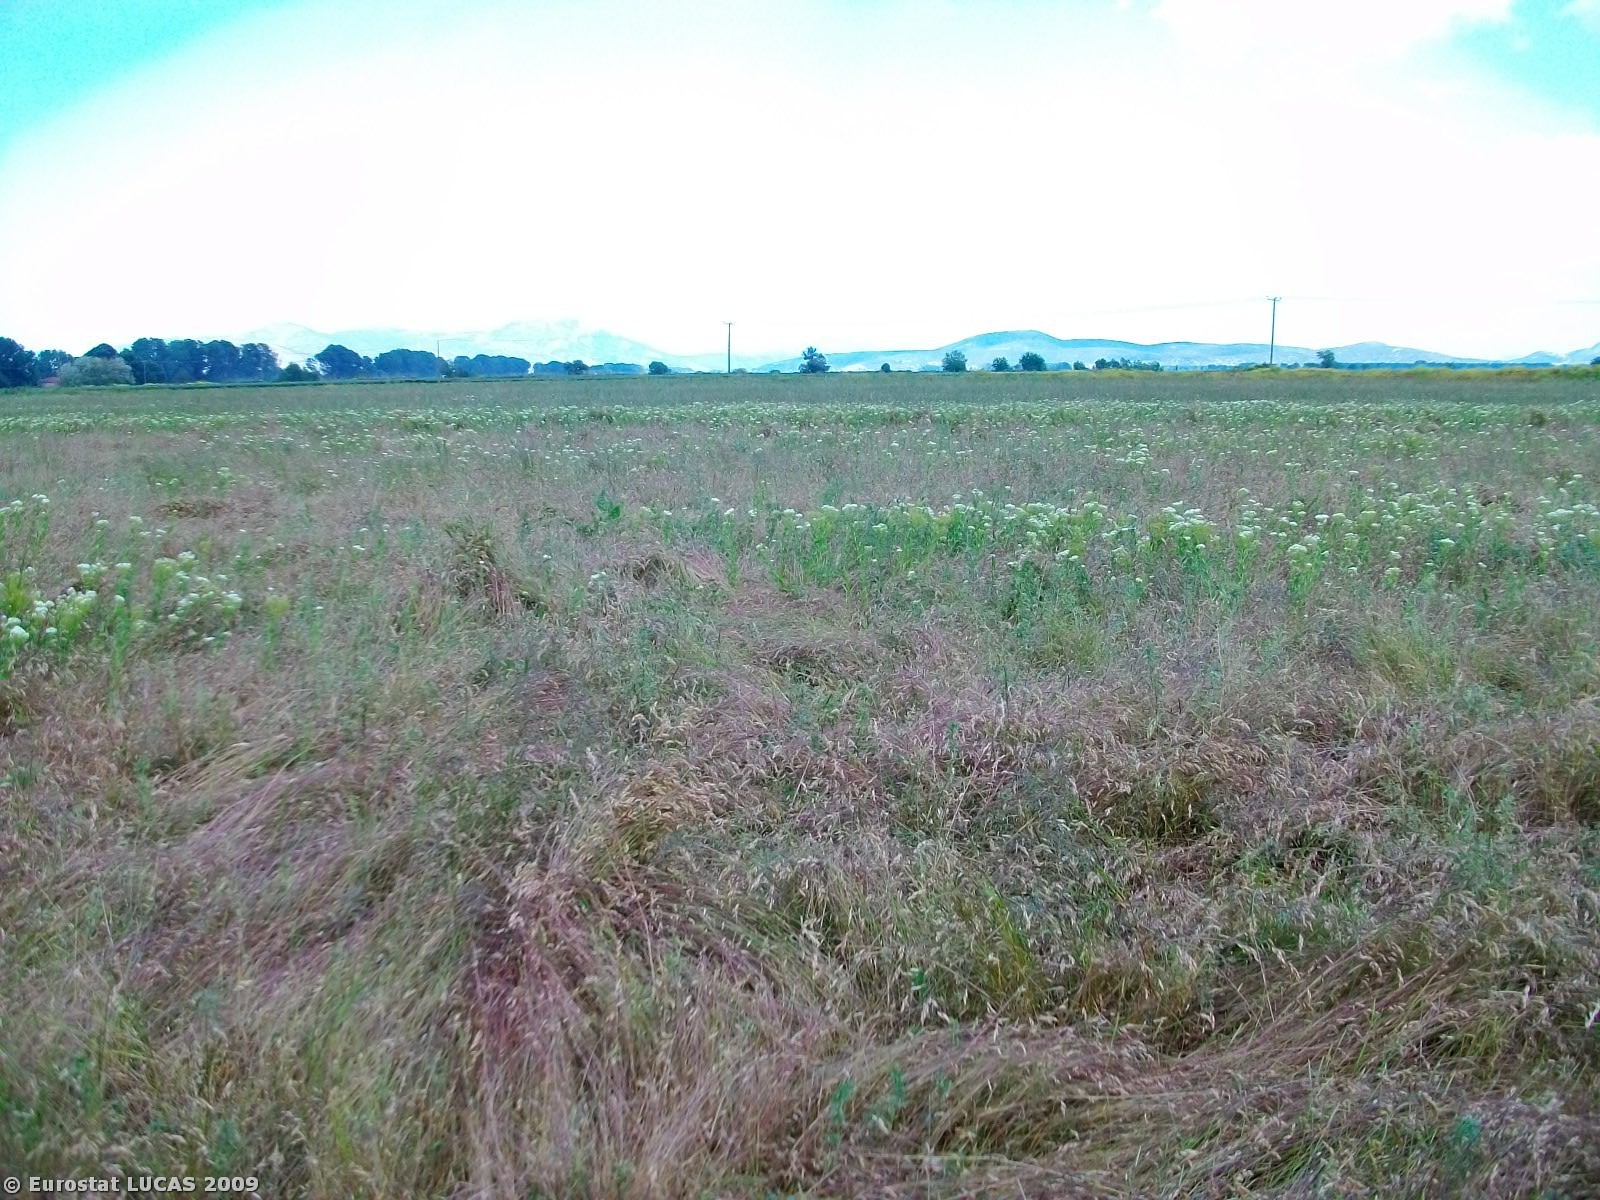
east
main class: Grassland
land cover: Spontaneously vegetated surfaces
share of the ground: > 75 %
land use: Fallow land
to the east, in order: Spontaneously vegetated surfaces; Durum wheat; Electric lines; Durum wheat
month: May
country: GR
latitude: 38.4328
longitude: 23.0973
